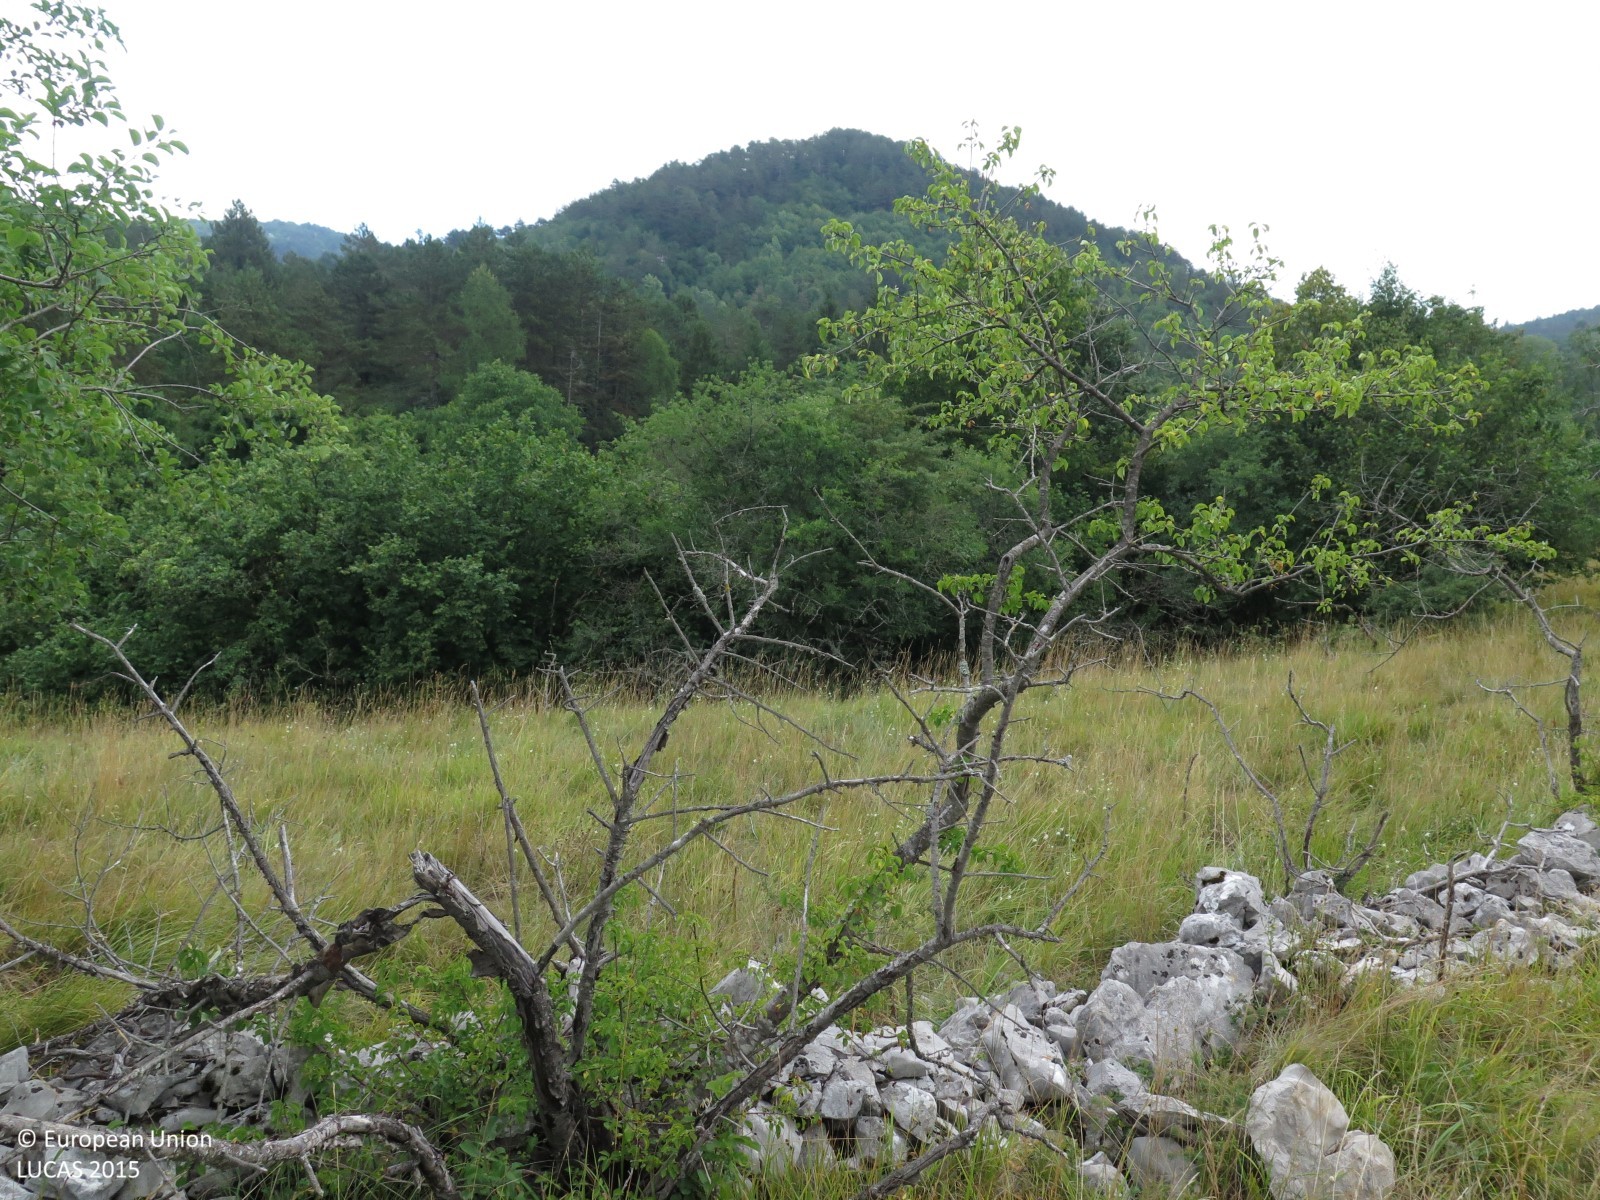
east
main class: Grassland
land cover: Grassland with sparse tree/shrub cover
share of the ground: > 75 %
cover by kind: herbaceous plants 90 %, broadleaved forest trees 5 %, shrubs 5 %
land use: Abandoned areas
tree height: < 5 m
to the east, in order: Grassland with sparse tree/shrub cover; Broadleaved woodland; Shrubland with sparse tree cover; Broadleaved woodland; Rocks and stones; Broadleaved woodland; Rocks and stones; Broadleaved woodland; Shrubland with sparse tree cover; Grassland with sparse tree/shrub cover; Broadleaved woodland
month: July
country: HR
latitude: 45.4439
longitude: 14.0736
